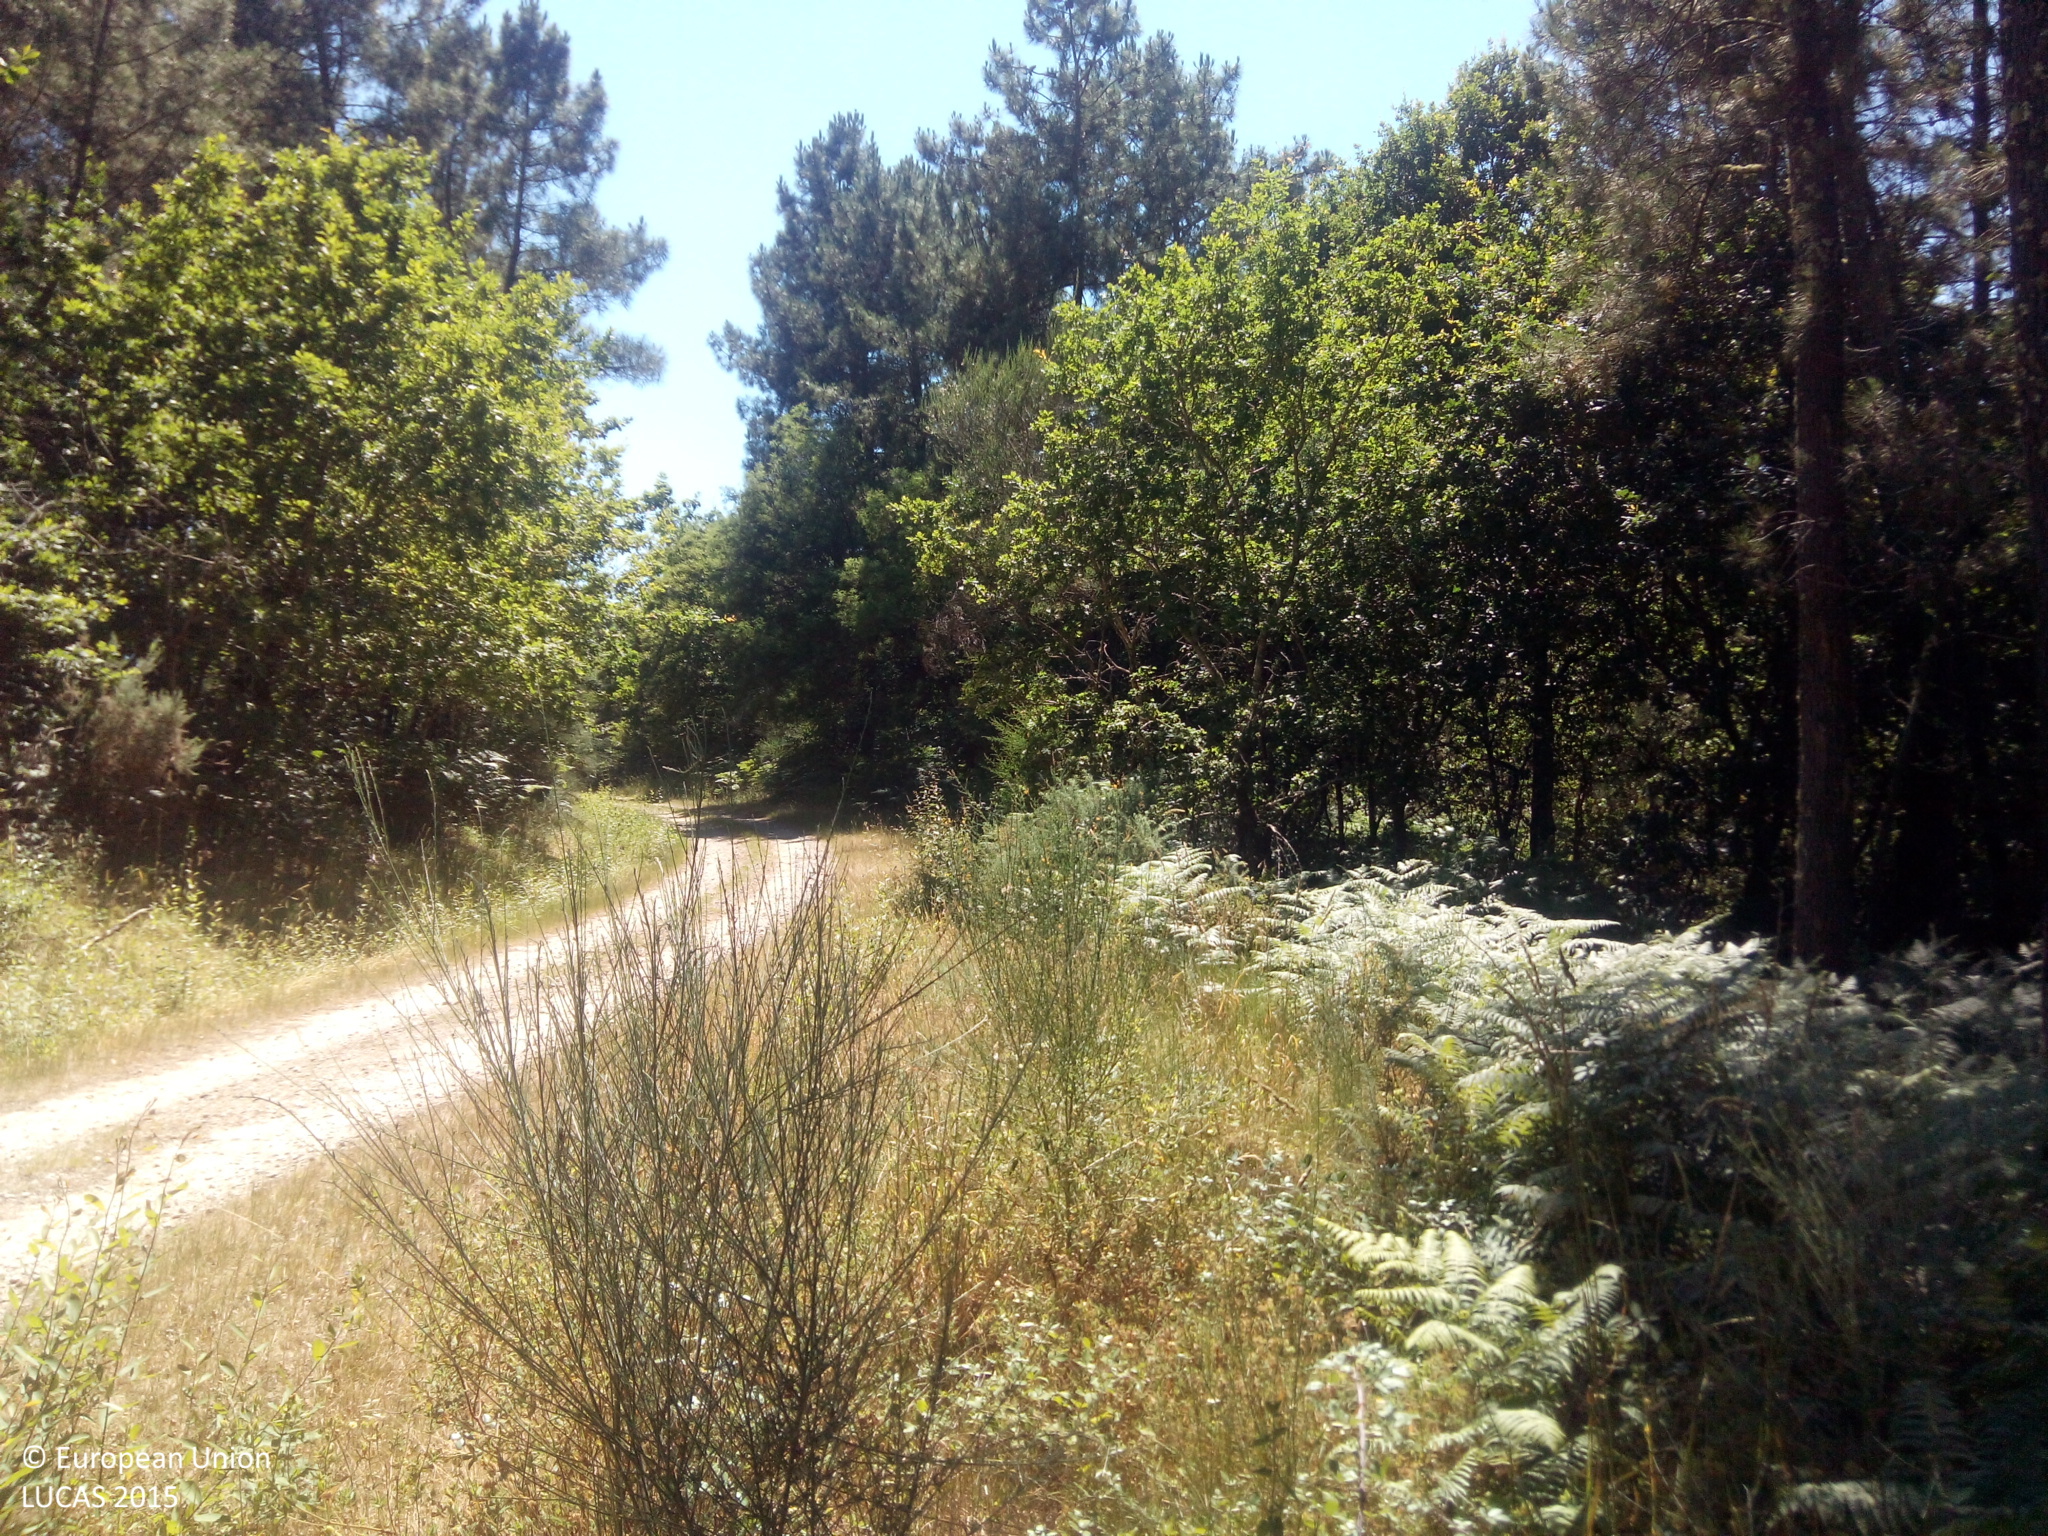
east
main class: Woodland
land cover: Pine dominated mixed woodland
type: hemiboreal forest and nemoral coniferous forest and mixed broadleaved-coniferous forest
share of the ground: > 75 %
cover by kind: coniferous forest trees 75 %, broadleaved forest trees 25 %
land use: Forestry
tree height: > 5 m
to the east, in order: Pine dominated mixed woodland; Ditches and canals; Grass margins; Tracks; Ditches and canals; Pine dominated coniferous woodland
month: June
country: ES
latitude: 42.7586
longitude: -8.4154
